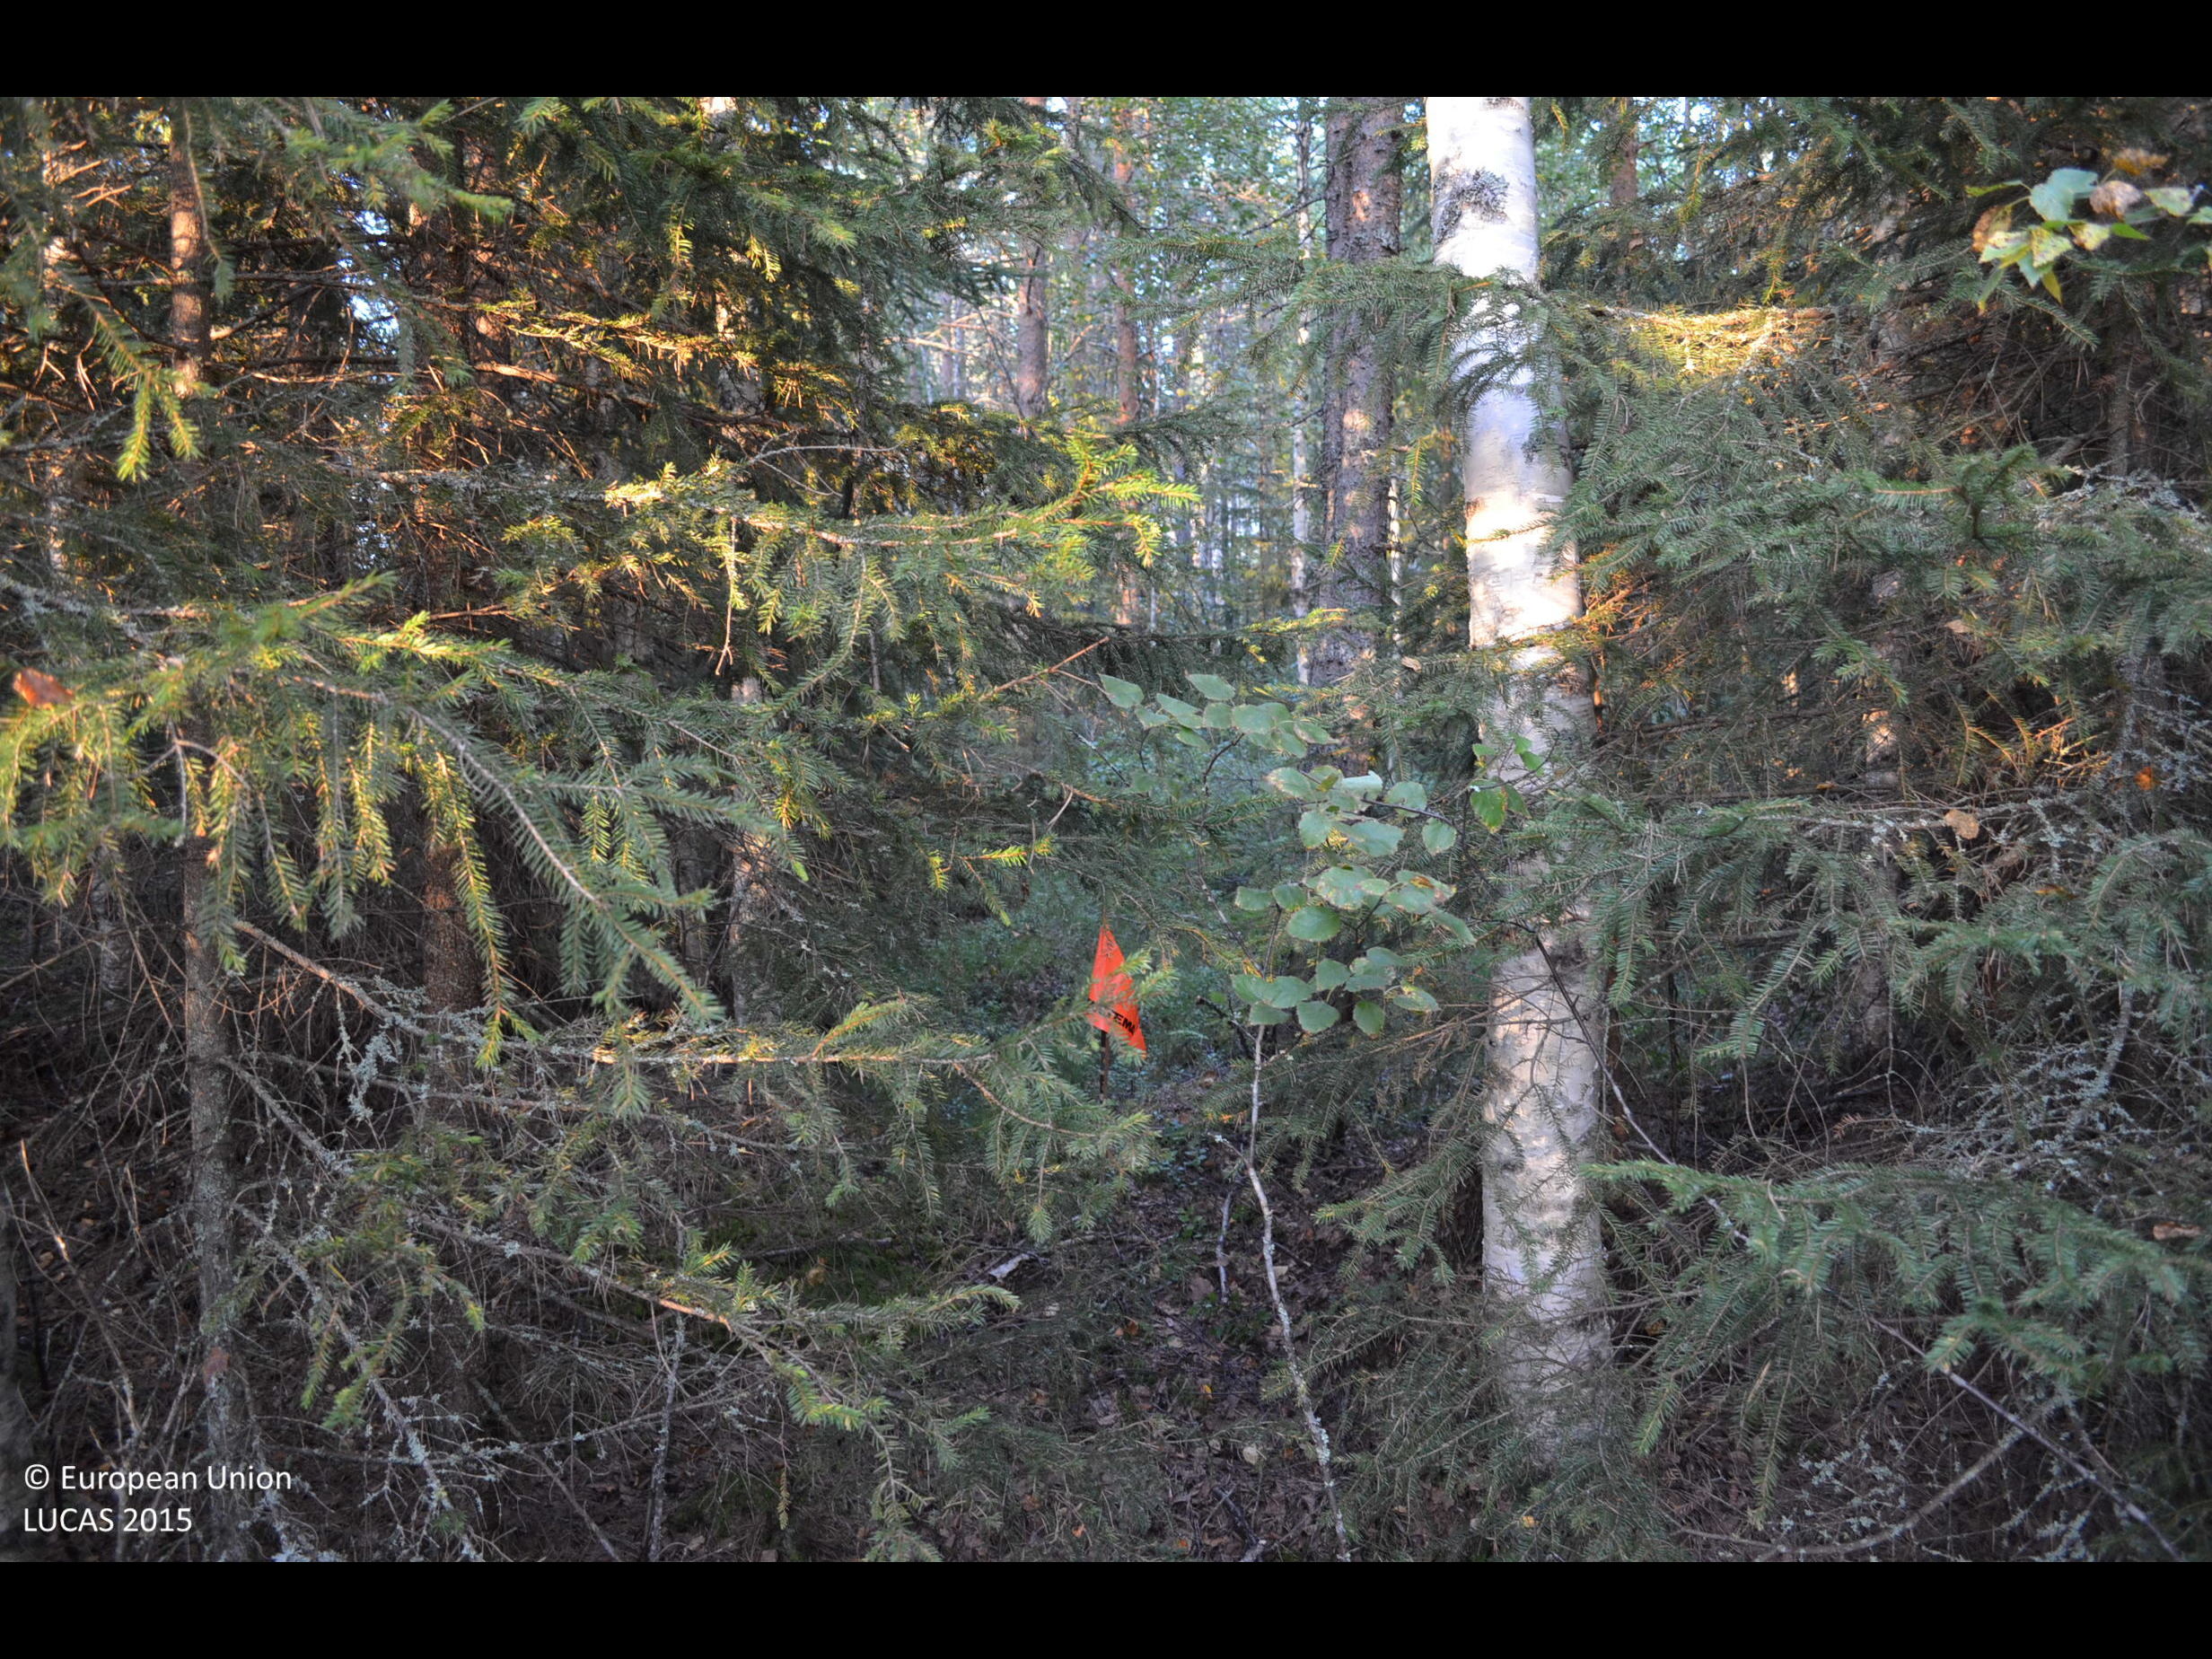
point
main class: Woodland
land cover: Other mixed woodland
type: boreal forest
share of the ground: > 75 %
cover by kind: coniferous forest trees 45 %, broadleaved forest trees 40 %, shrubs 5 %, herbaceous plants 5 %
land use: Forestry
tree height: > 5 m
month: August
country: FI
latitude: 62.4965
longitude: 24.4722
